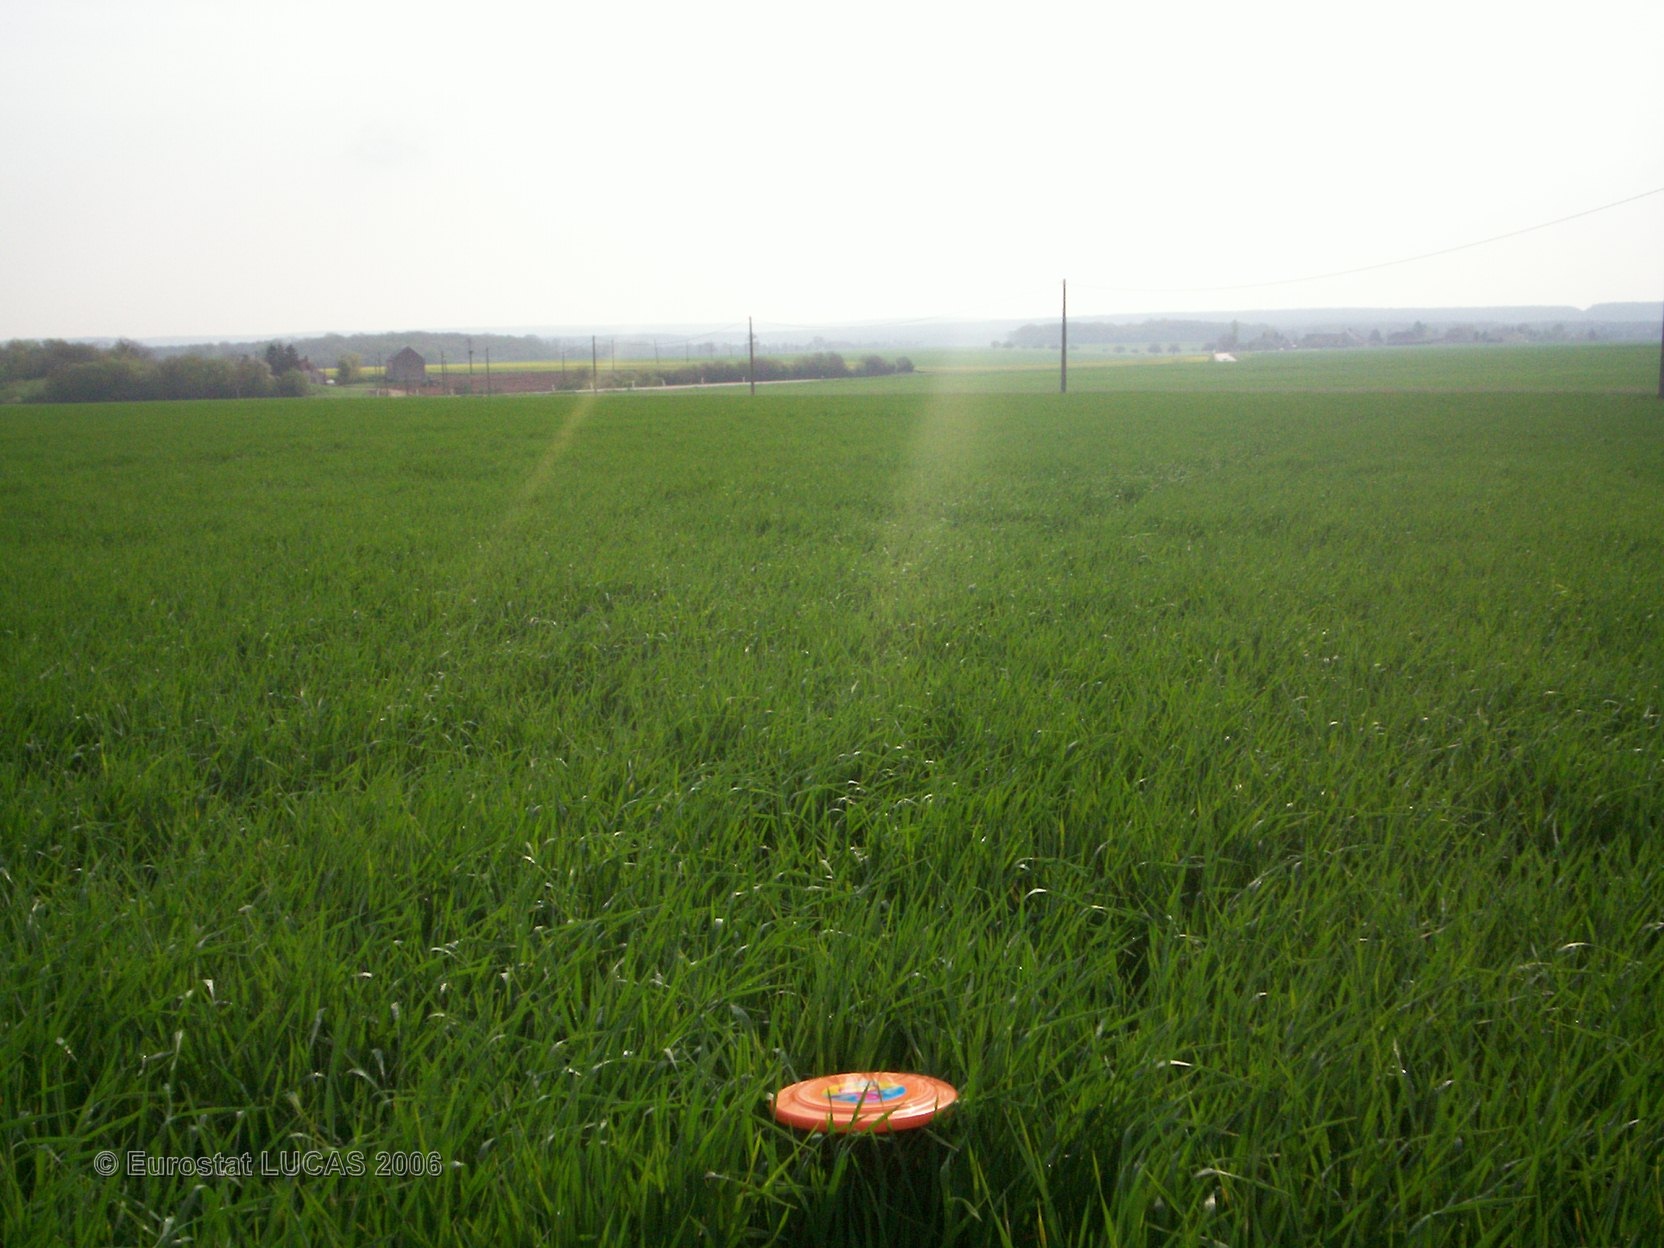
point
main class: Cropland
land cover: Barley
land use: Agriculture (excluding fallow land and kitchen gardens)
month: April
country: FR
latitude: 47.2298
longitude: 3.0877
